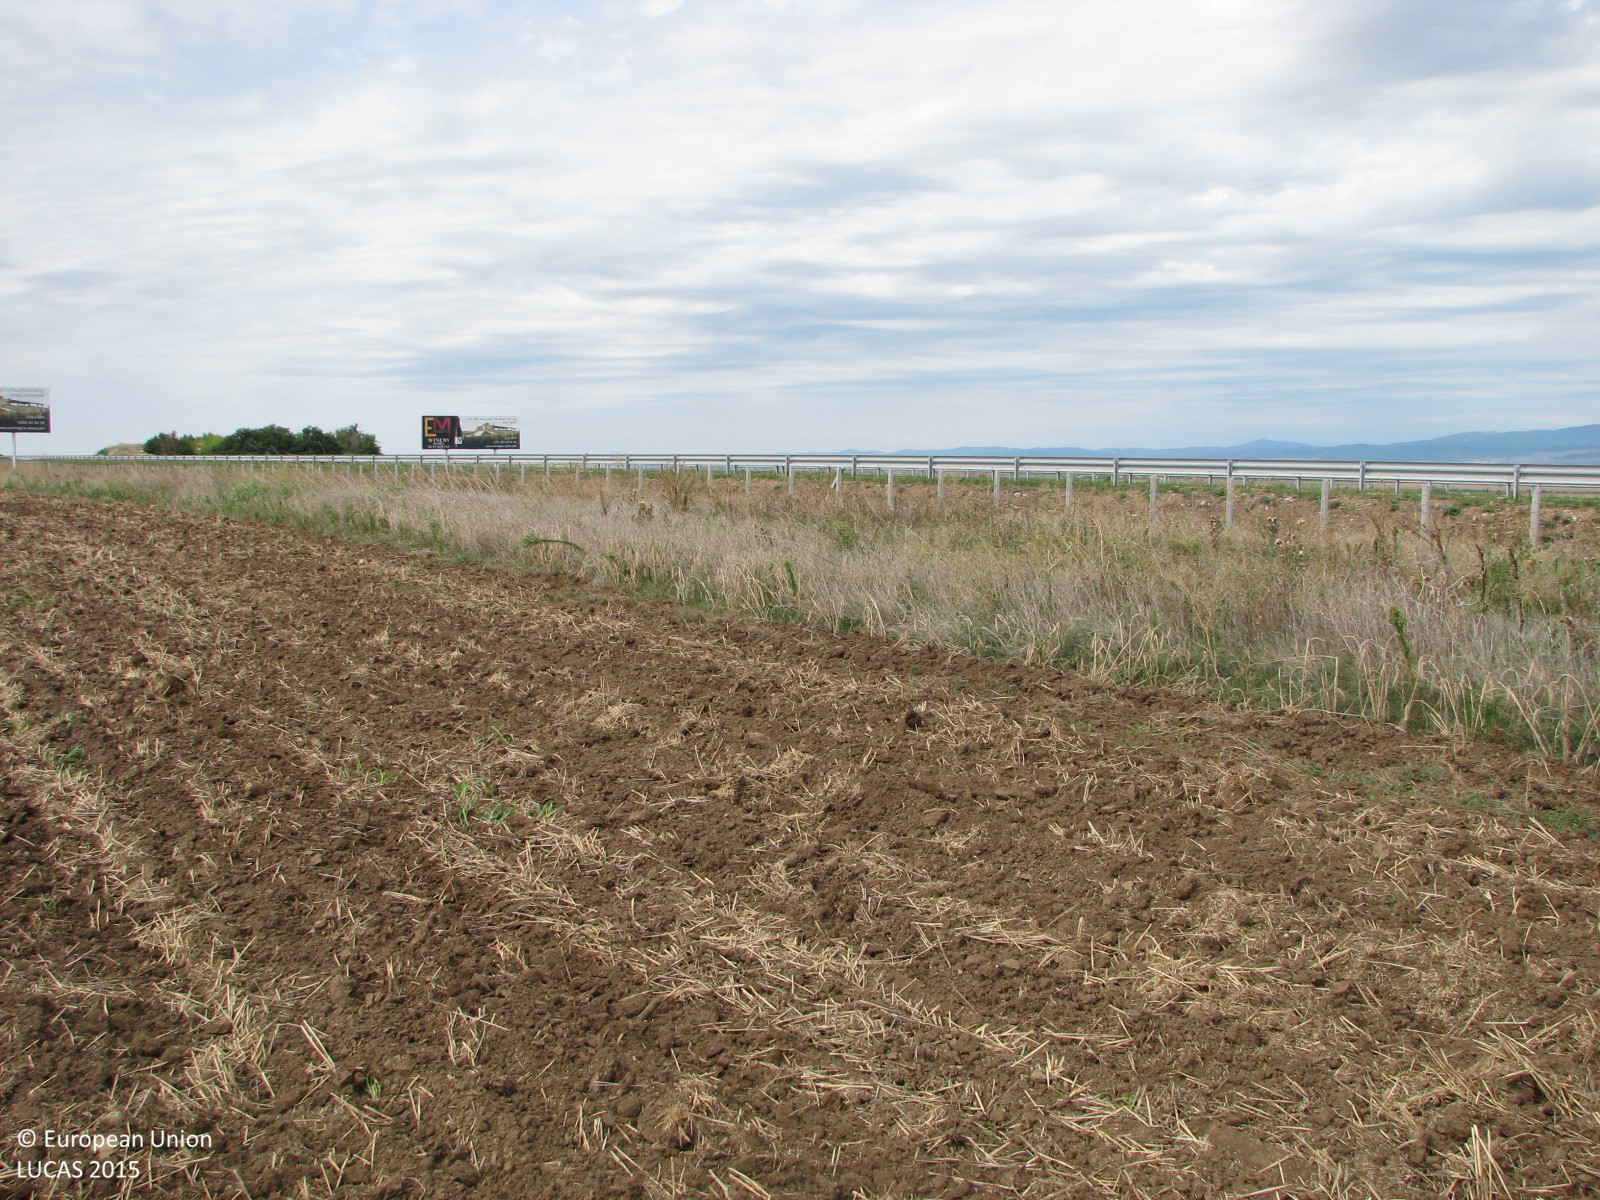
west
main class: Cropland
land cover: Common wheat
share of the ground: < 10 %
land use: Agriculture (excluding fallow land and kitchen gardens)
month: September
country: BG
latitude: 42.4492
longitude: 26.0455
